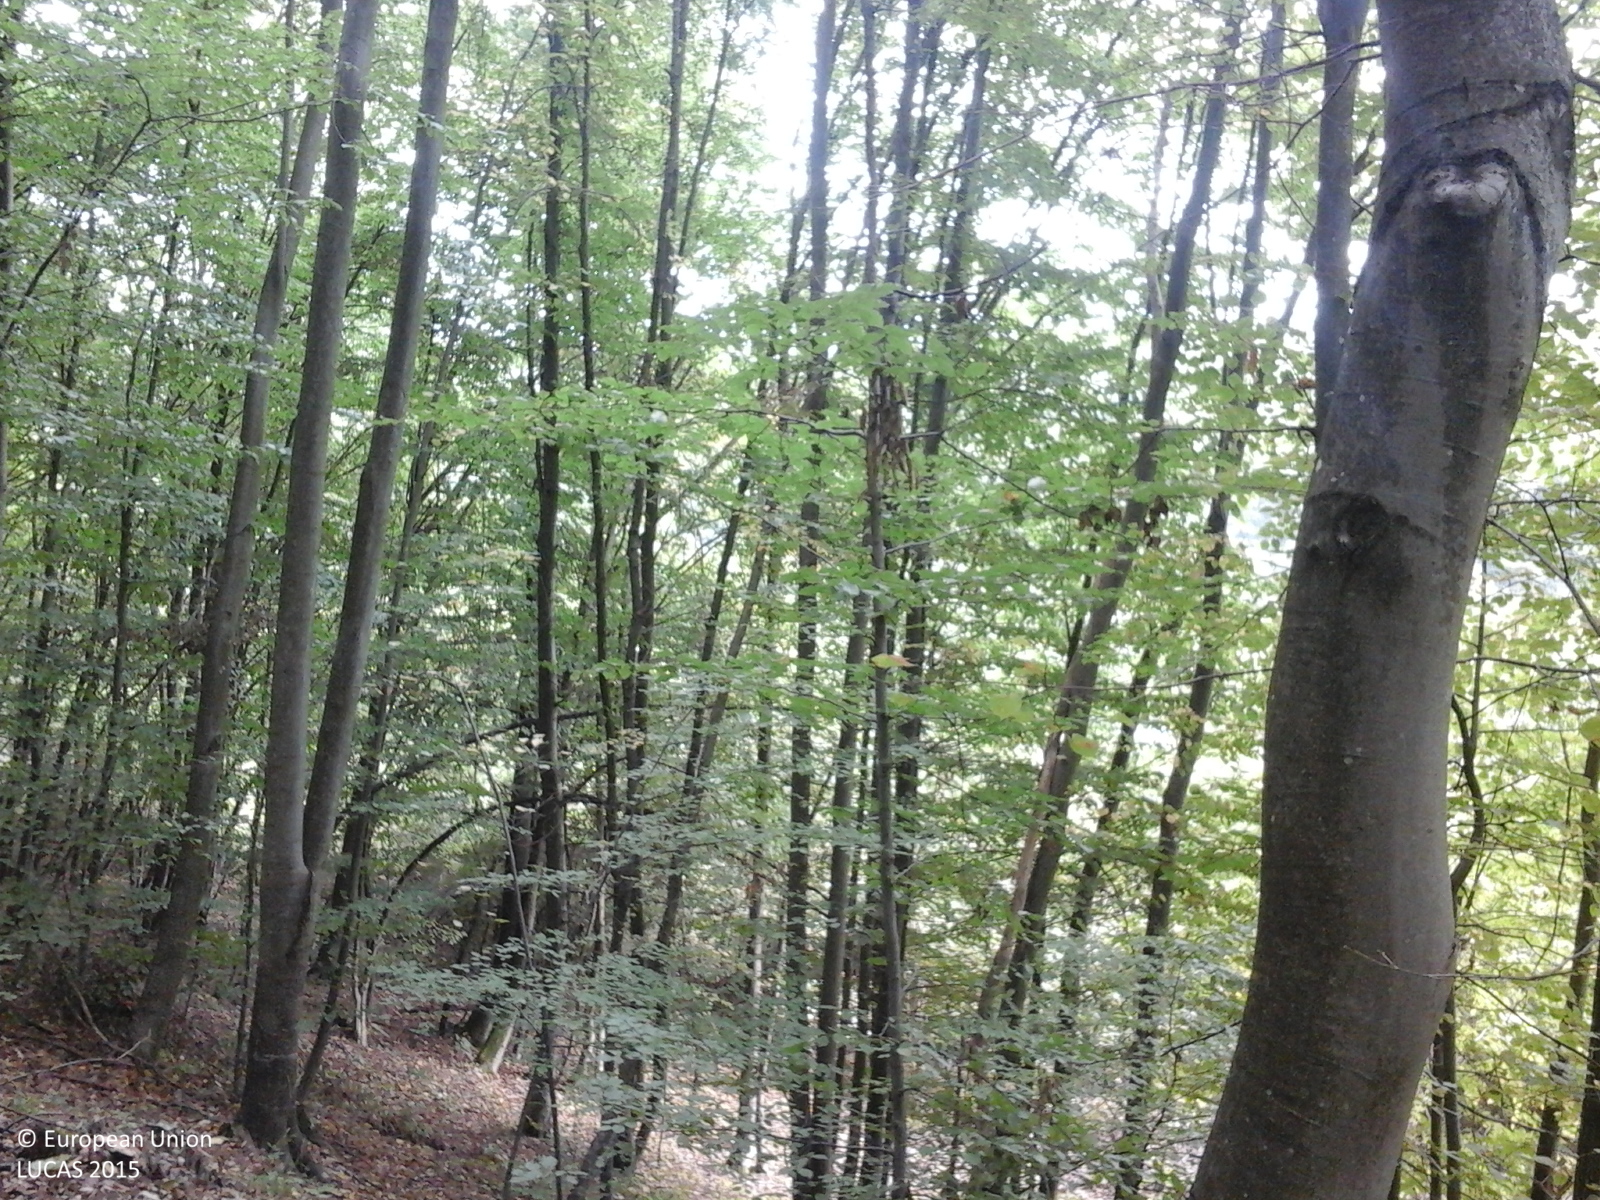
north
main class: Woodland
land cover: Broadleaved woodland
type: beech forest
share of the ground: > 75 %
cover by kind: broadleaved forest trees 100 %
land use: Forestry
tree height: > 5 m
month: September
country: RO
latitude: 45.9460
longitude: 21.9994
